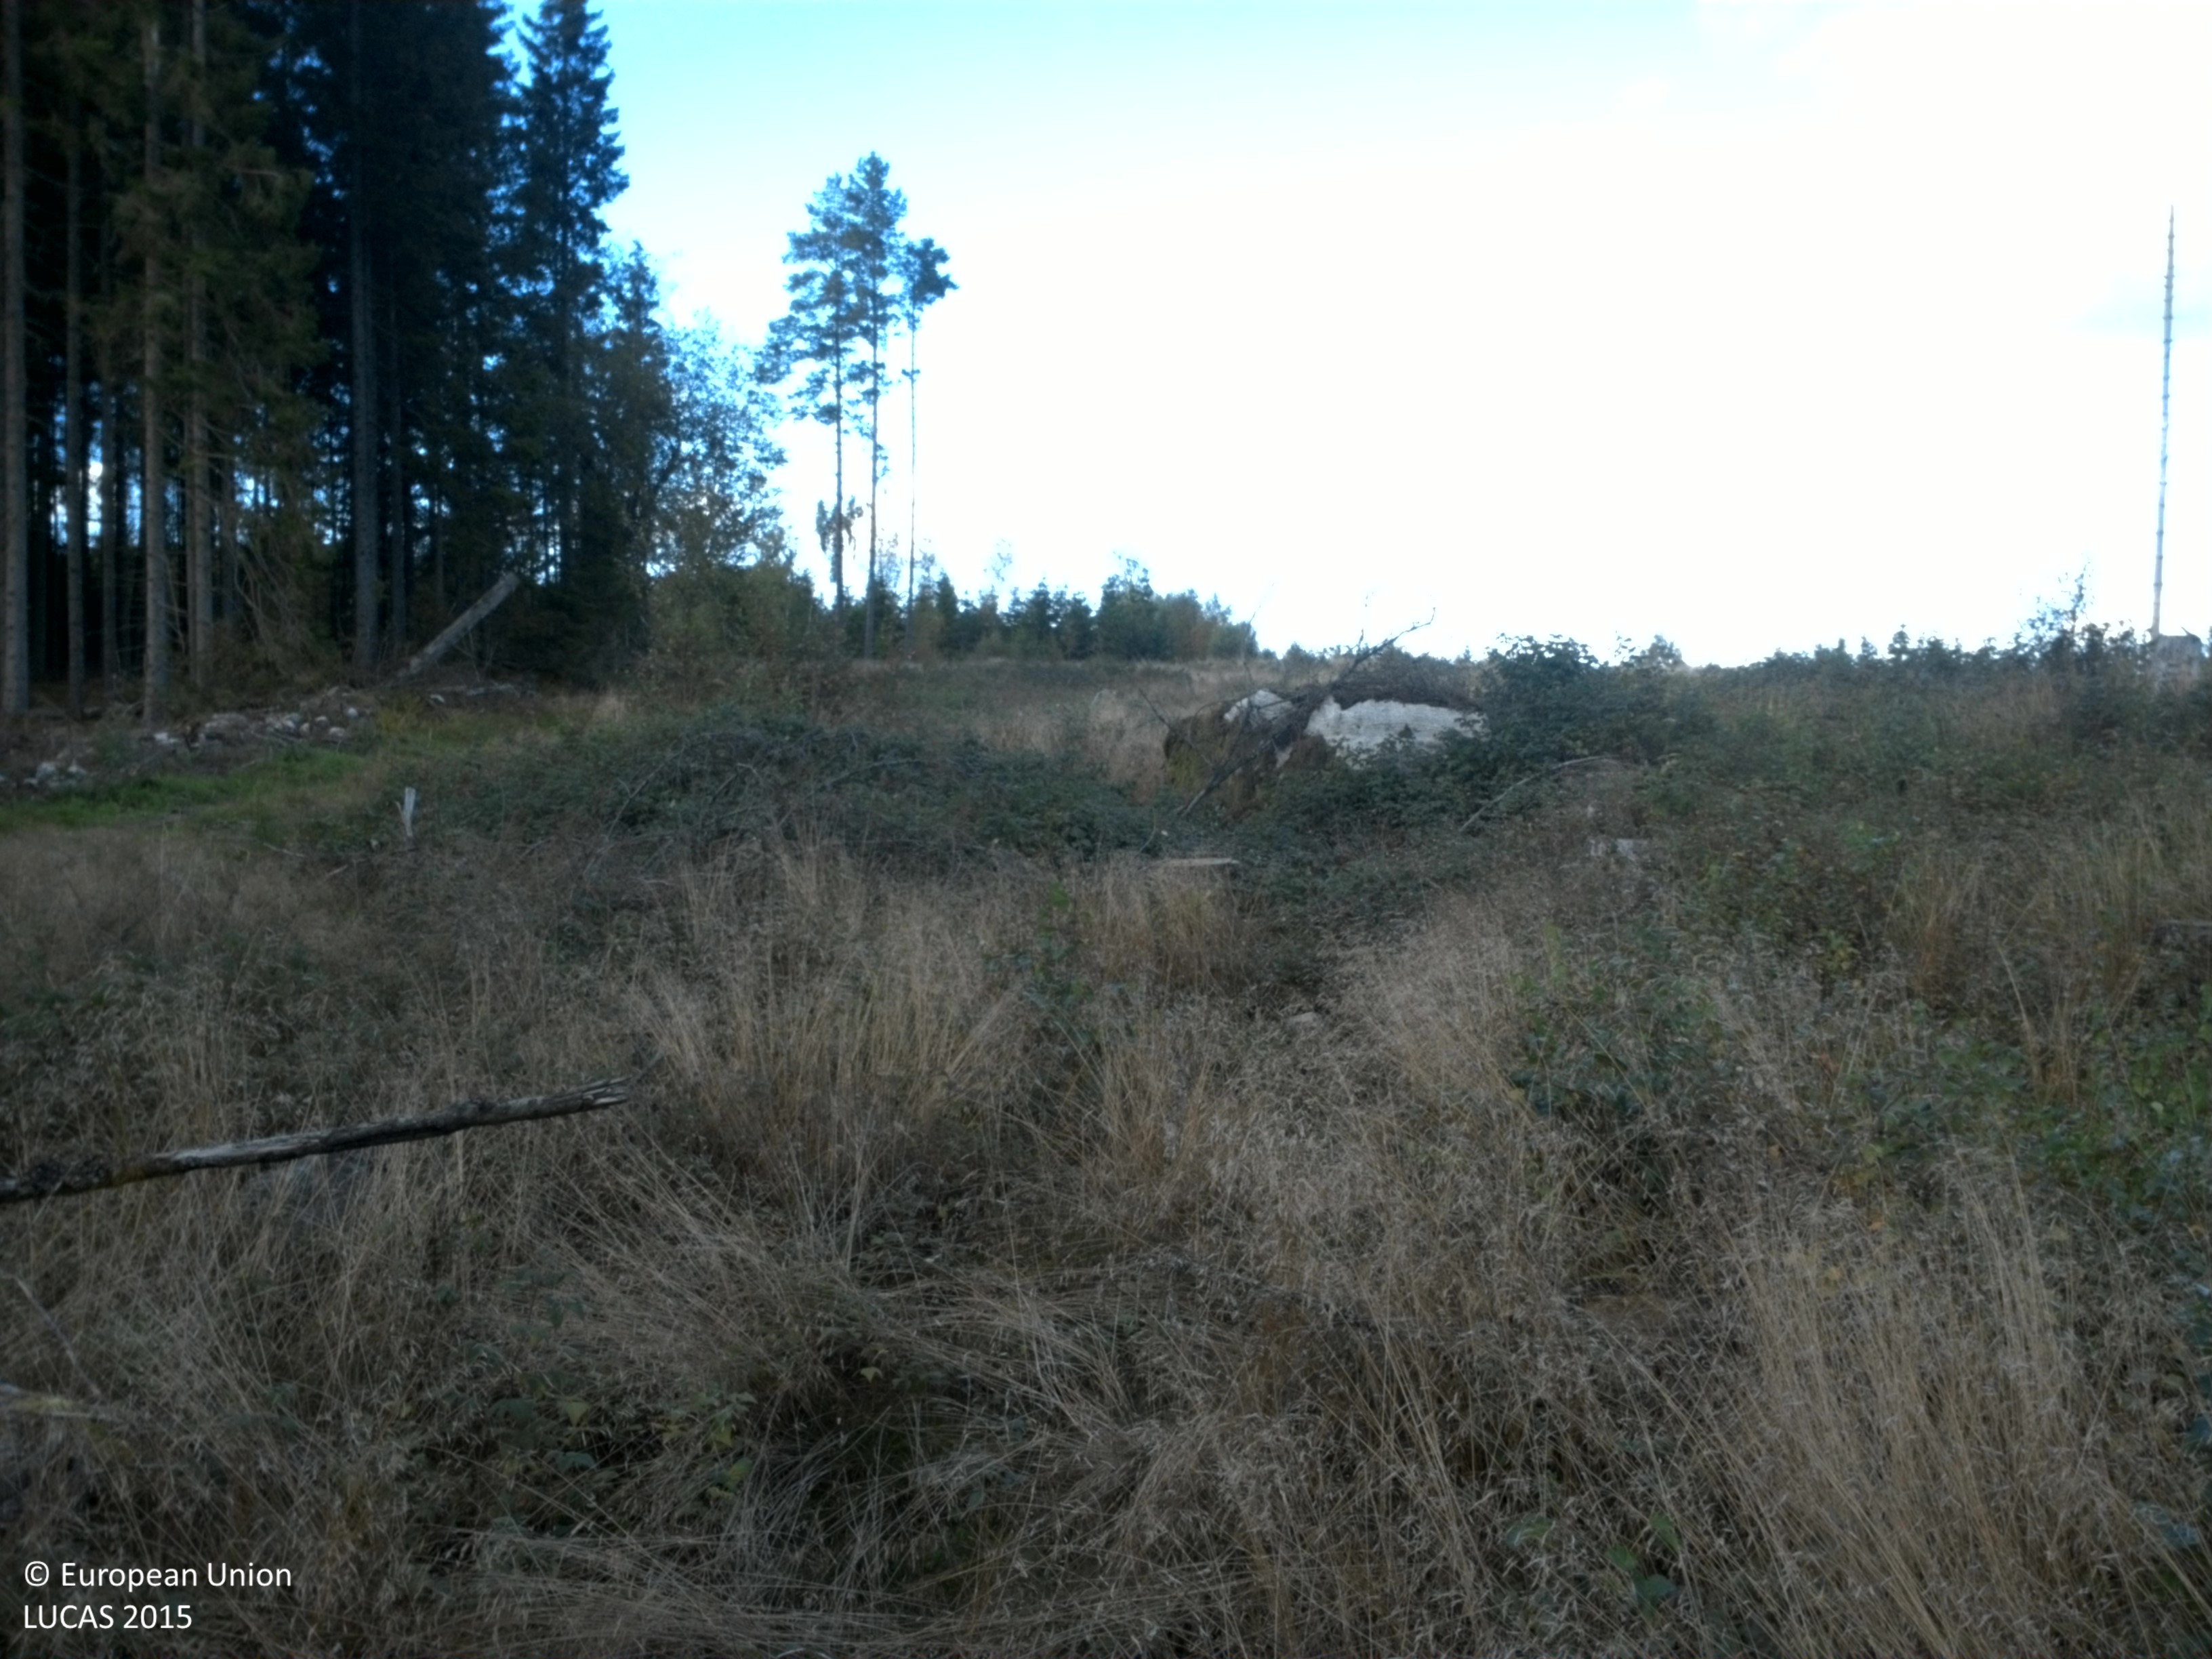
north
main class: Shrubland
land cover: Shrubland with sparse tree cover
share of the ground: 50 - 75 %
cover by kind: herbaceous plants 50 %, shrubs 45 %, broadleaved forest trees 5 %
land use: Forestry
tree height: < 5 m
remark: Clear cut
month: September
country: SE
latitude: 57.8775
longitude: 13.1146
